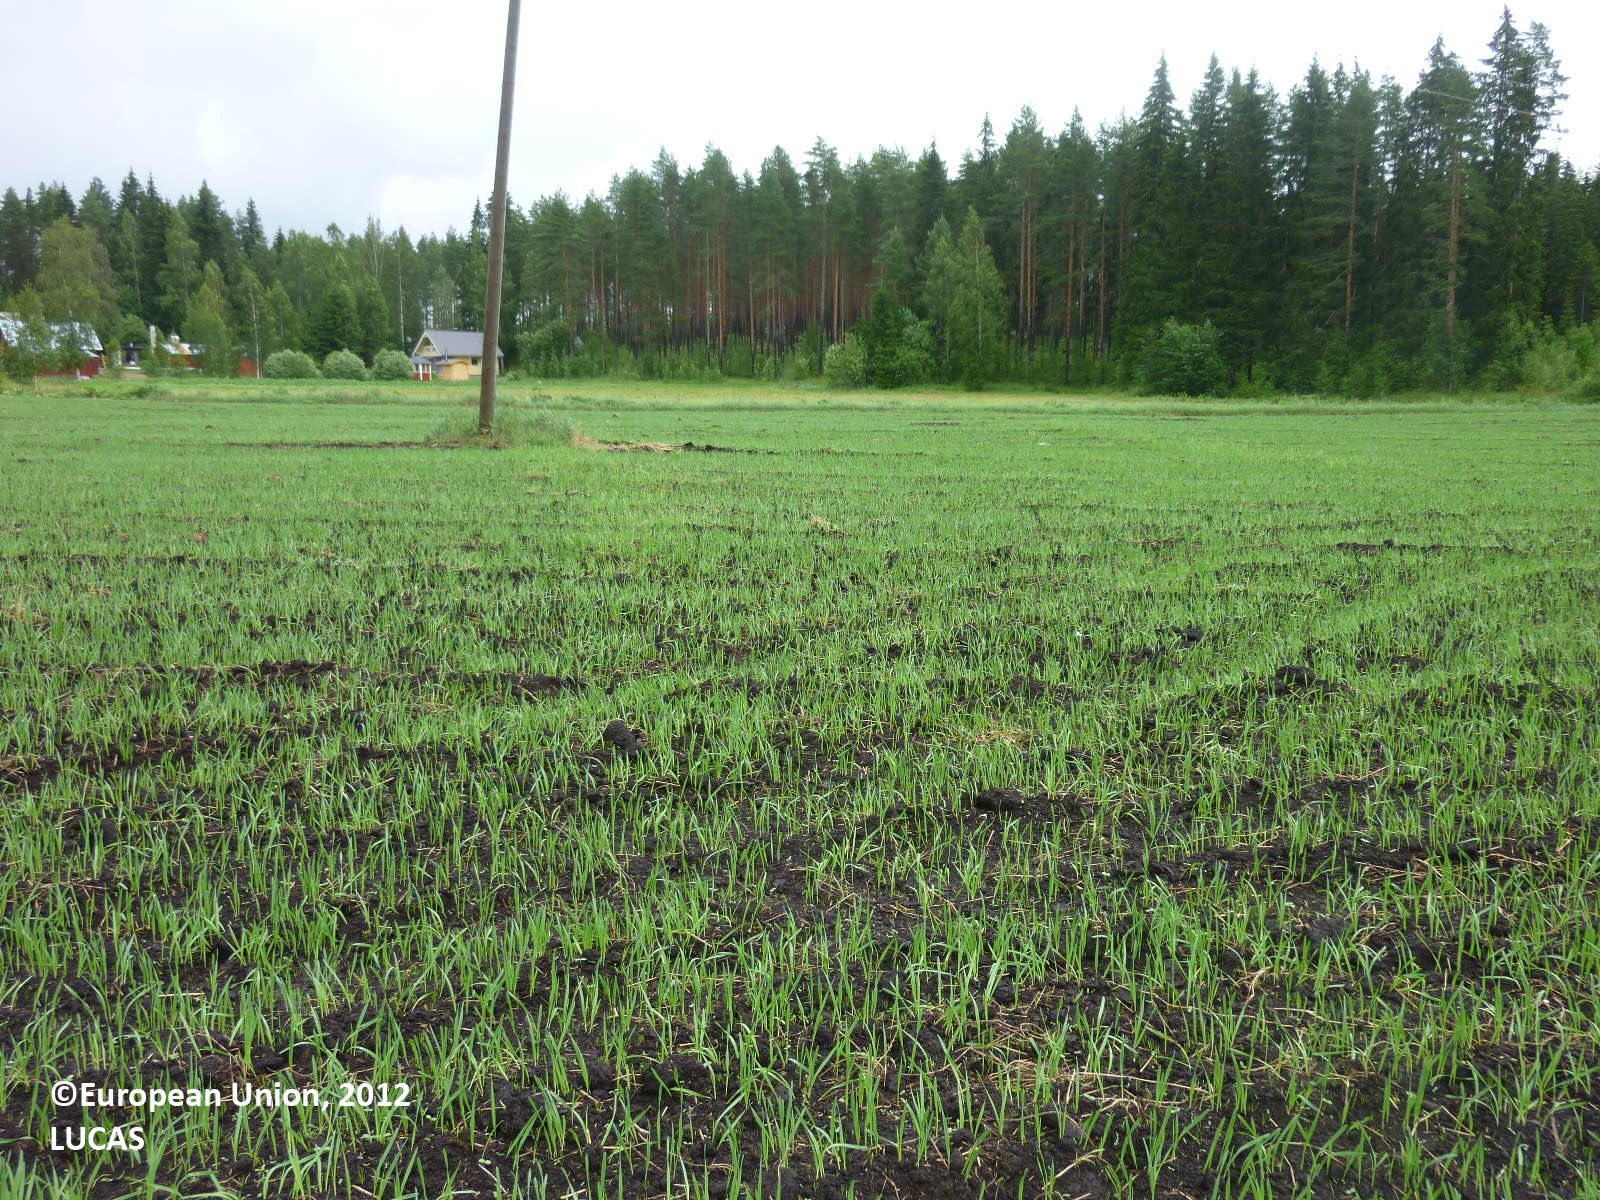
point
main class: Cropland
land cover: Oats
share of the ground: > 75 %
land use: Agriculture (excluding fallow land and kitchen gardens)
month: July
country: FI
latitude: 61.4651
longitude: 22.7340
